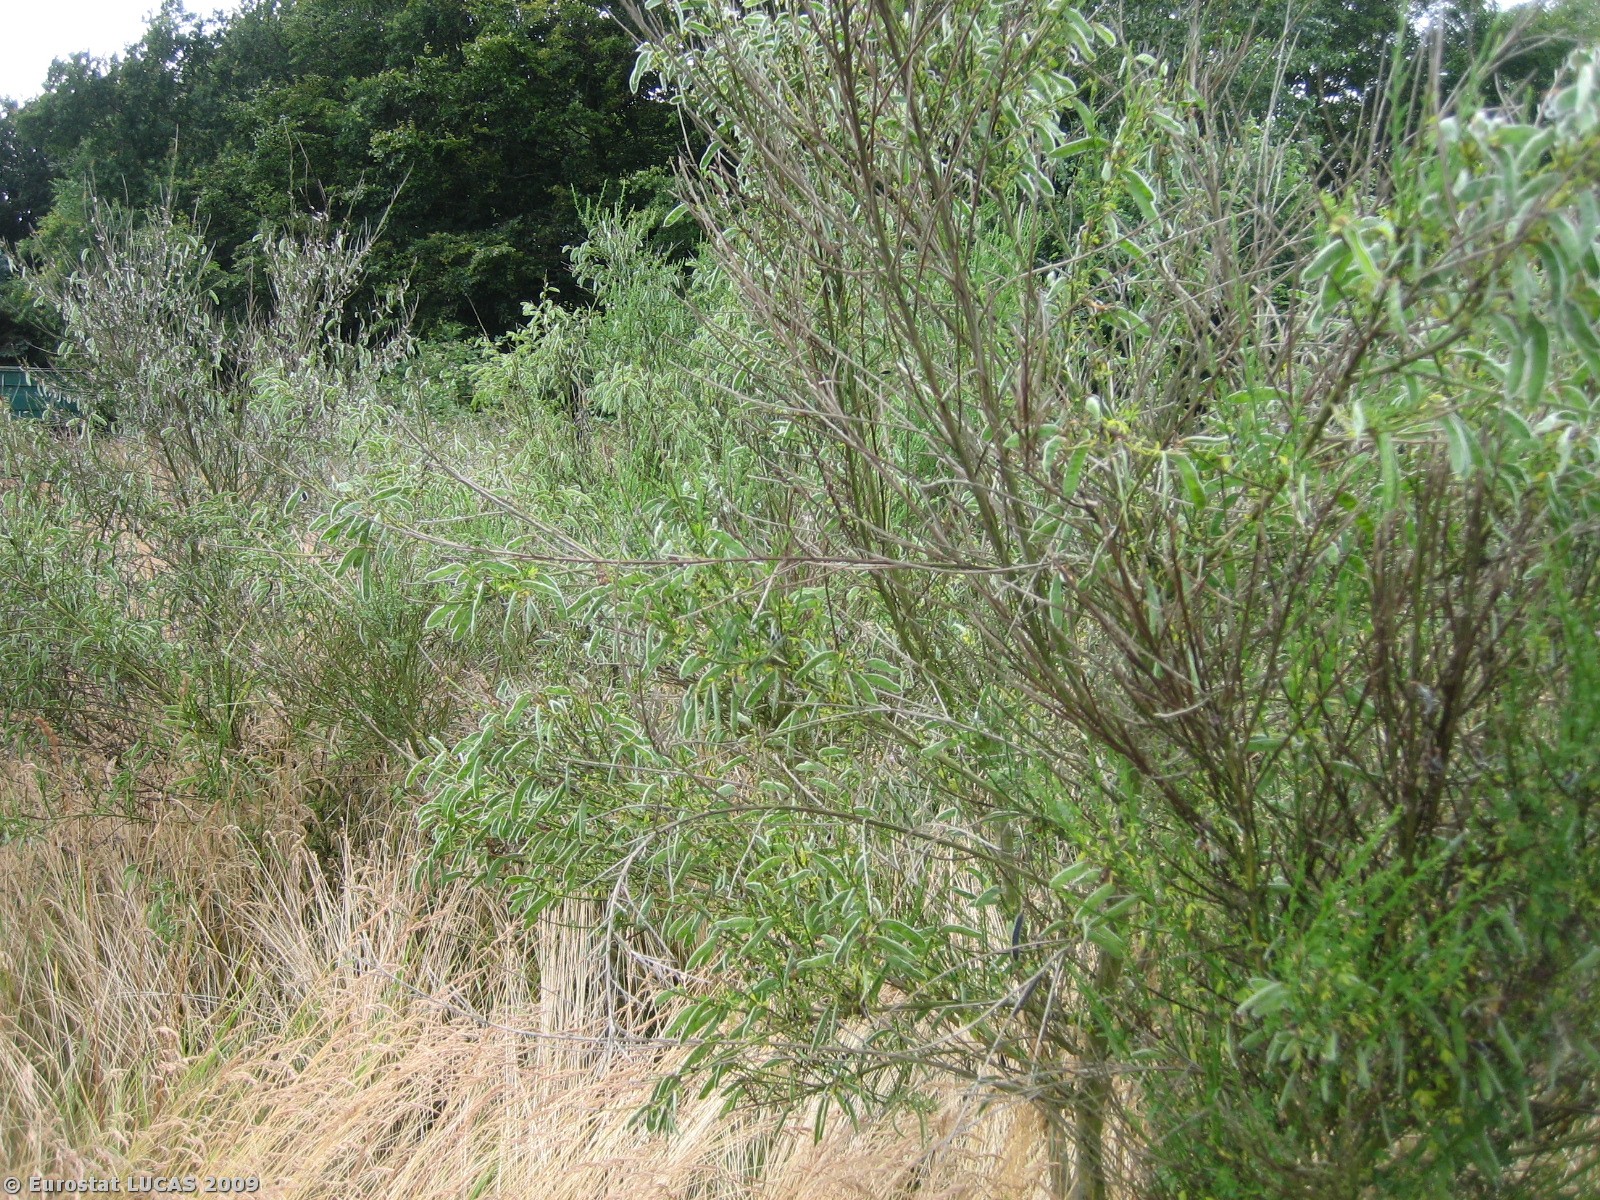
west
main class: Cropland
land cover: Rape and turnip rape
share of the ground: > 75 %
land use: Agriculture (excluding fallow land and kitchen gardens)
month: July
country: DK
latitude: 55.5138
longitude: 8.4969
